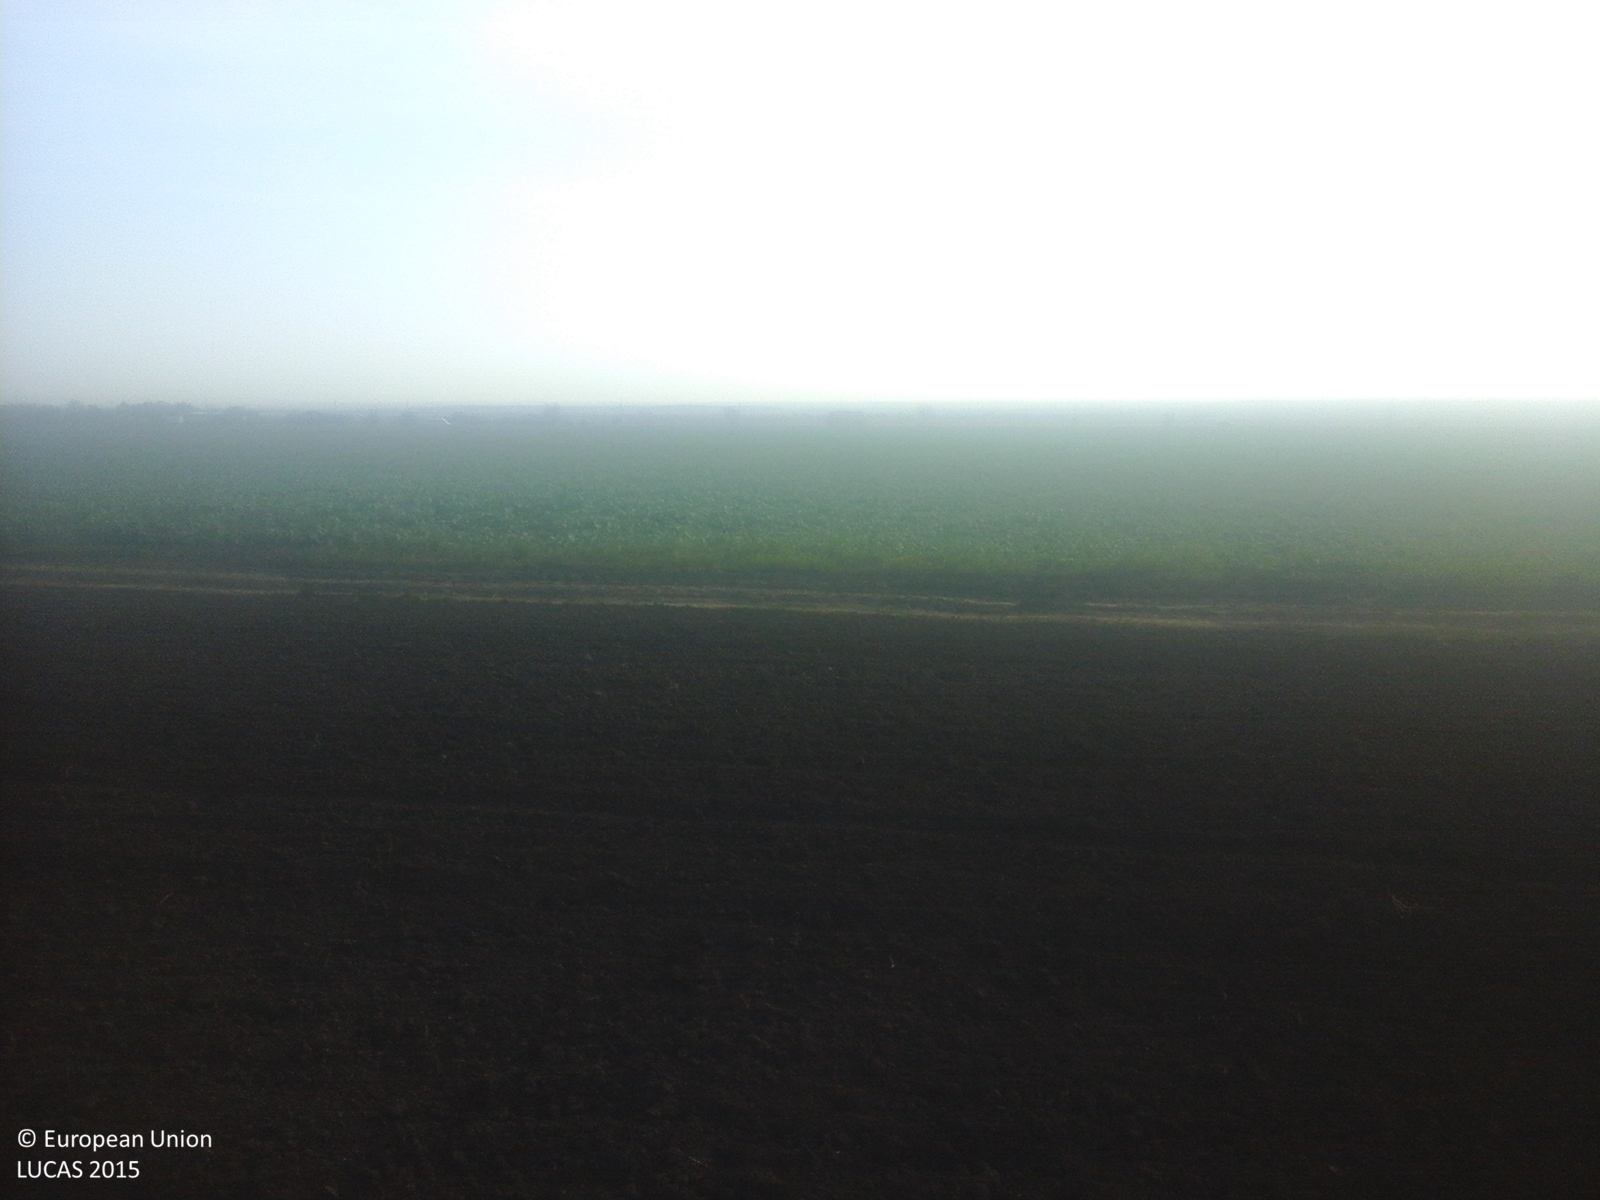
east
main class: Cropland
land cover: Common wheat
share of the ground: < 10 %
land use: Agriculture (excluding fallow land and kitchen gardens)
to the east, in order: Common wheat; Tracks; Rape and turnip rape
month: October
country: RO
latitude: 45.4117
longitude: 27.0443
